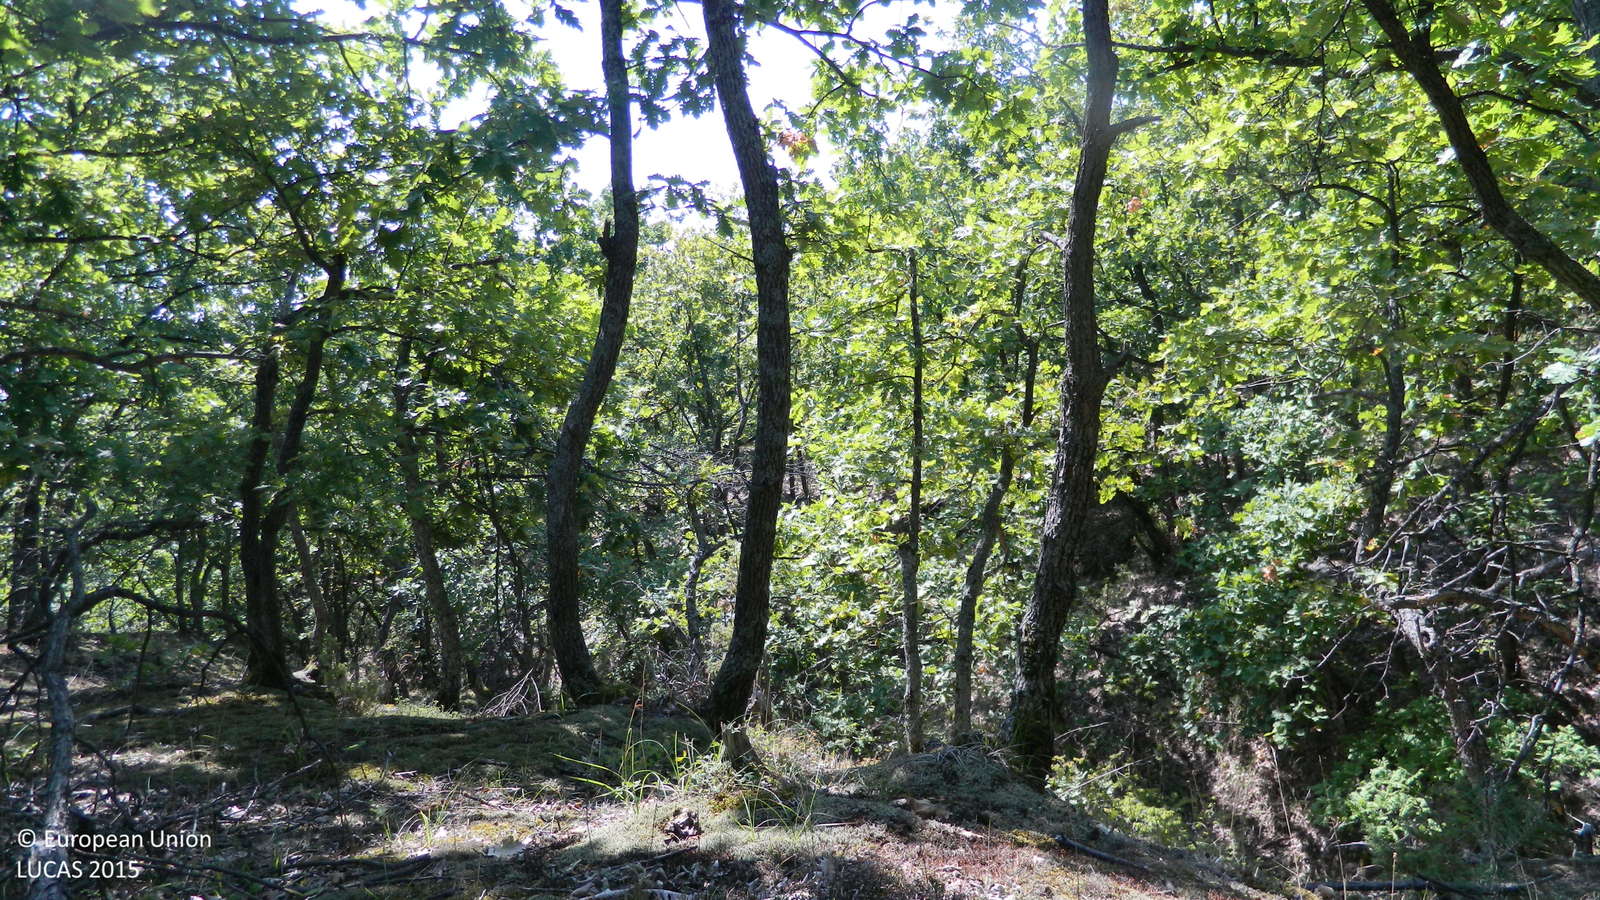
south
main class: Woodland
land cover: Broadleaved woodland
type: thermophilous deciduous forest
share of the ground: > 75 %
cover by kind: broadleaved forest trees 85 %, herbaceous plants 10 %, unconsolidated bare surface 5 %
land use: Forestry
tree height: > 5 m
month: September
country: BG
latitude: 41.6829
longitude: 25.6686
